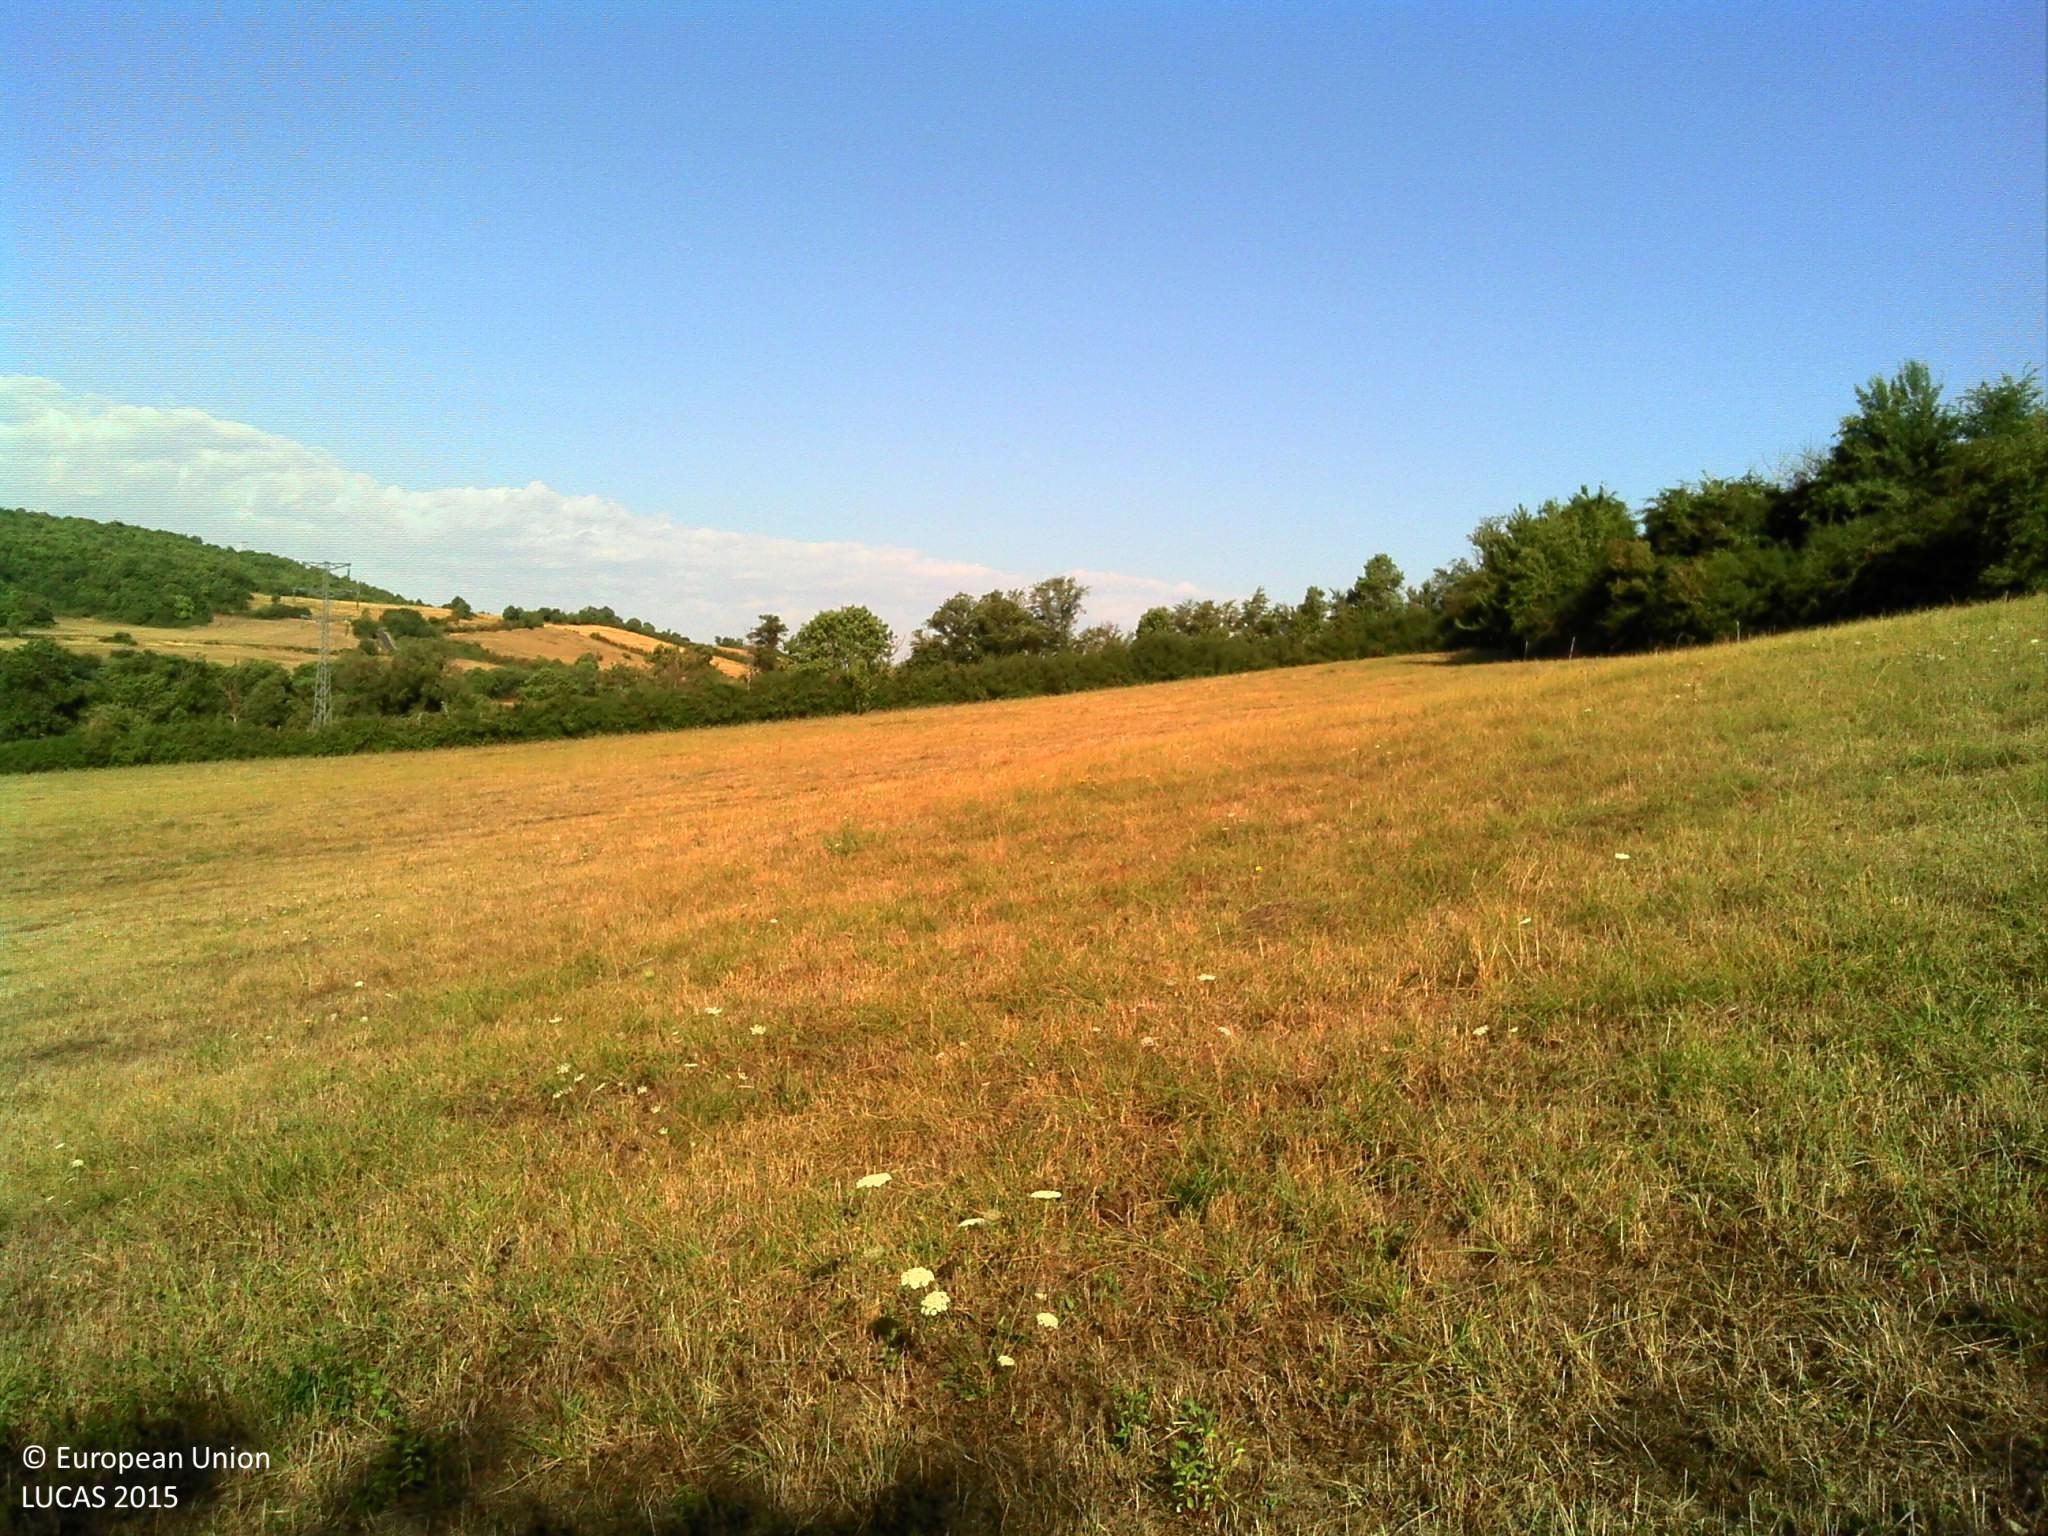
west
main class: Woodland
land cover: Broadleaved woodland
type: mesophytic deciduous forest
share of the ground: > 75 %
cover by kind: broadleaved forest trees 100 %
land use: Forestry
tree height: > 5 m
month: August
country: FR
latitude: 43.9034
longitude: 3.0966
